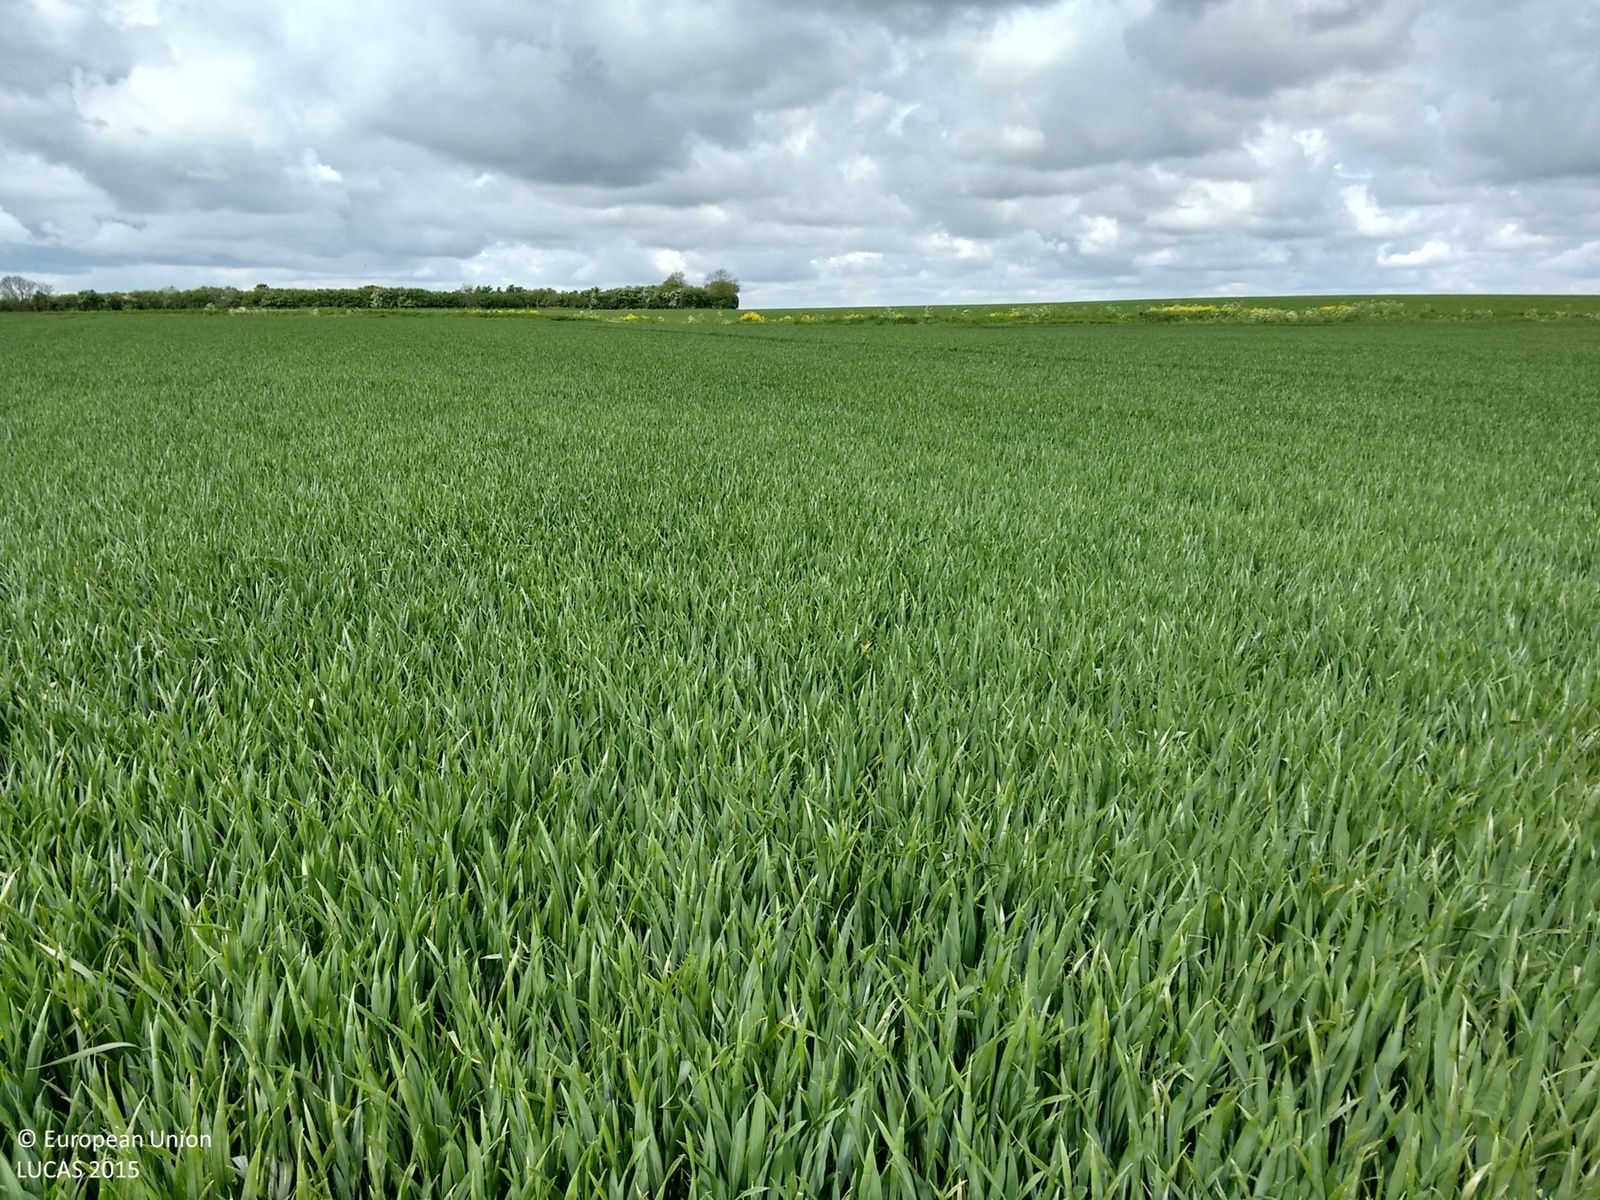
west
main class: Cropland
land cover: Common wheat
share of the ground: > 75 %
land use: Agriculture (excluding fallow land and kitchen gardens)
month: May
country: GB
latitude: 53.5101
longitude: -0.0294
